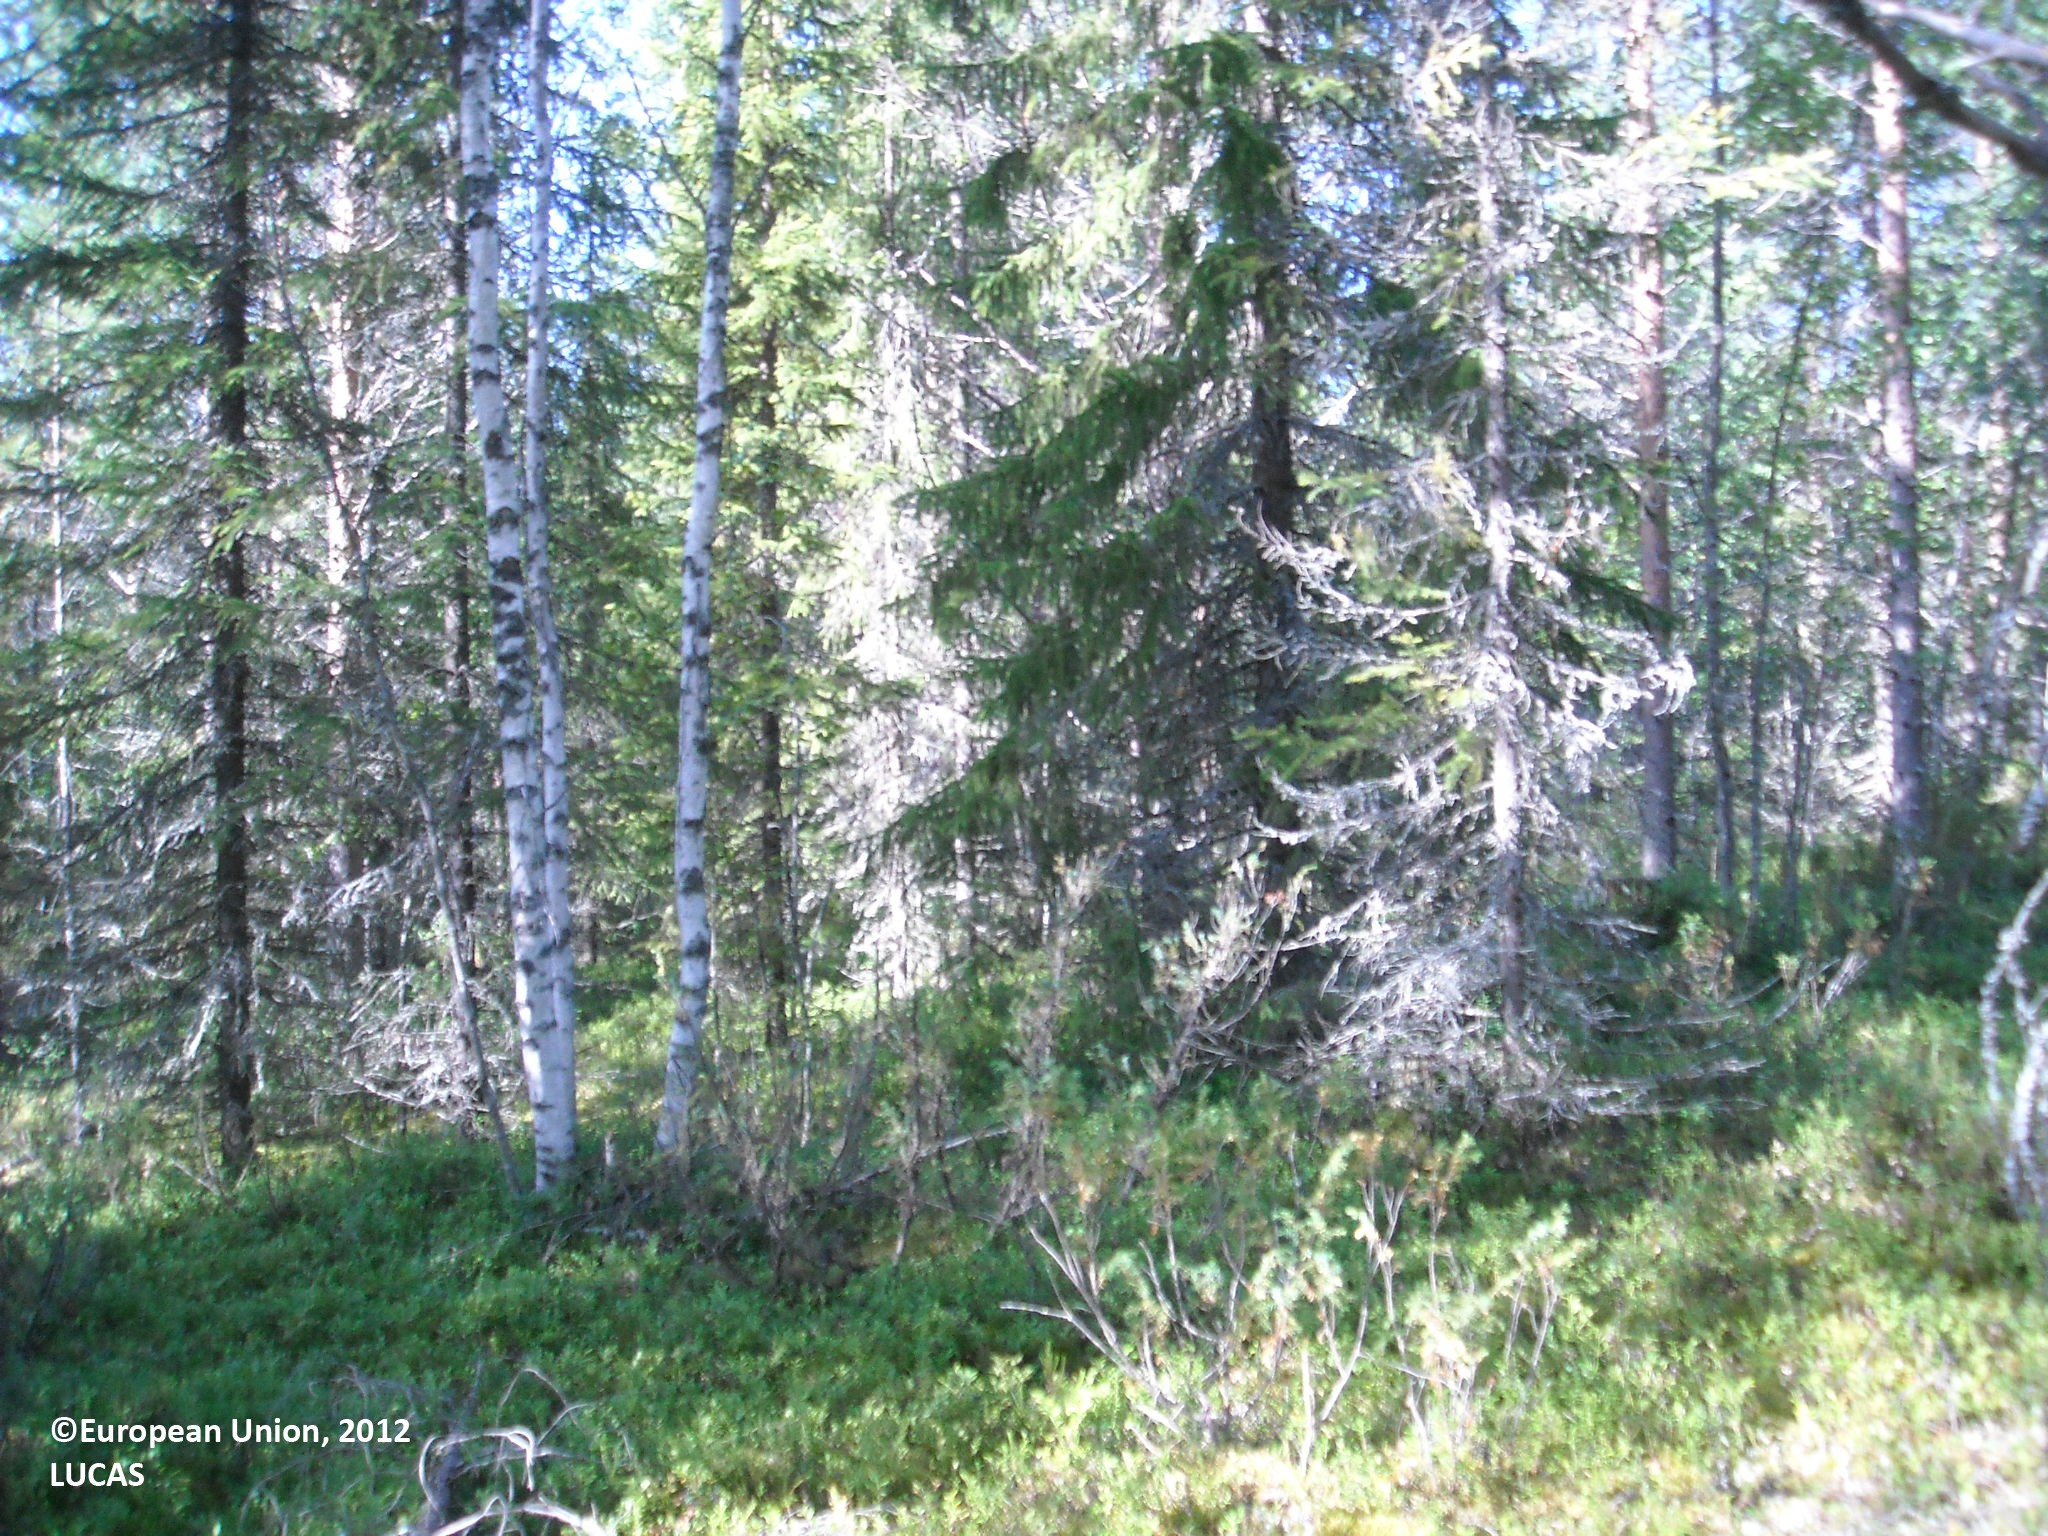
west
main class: Woodland
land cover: Other coniferous woodland
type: boreal forest
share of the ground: 50 - 75 %
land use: Forestry
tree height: > 5 m
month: August
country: FI
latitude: 65.1210
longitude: 27.7163
